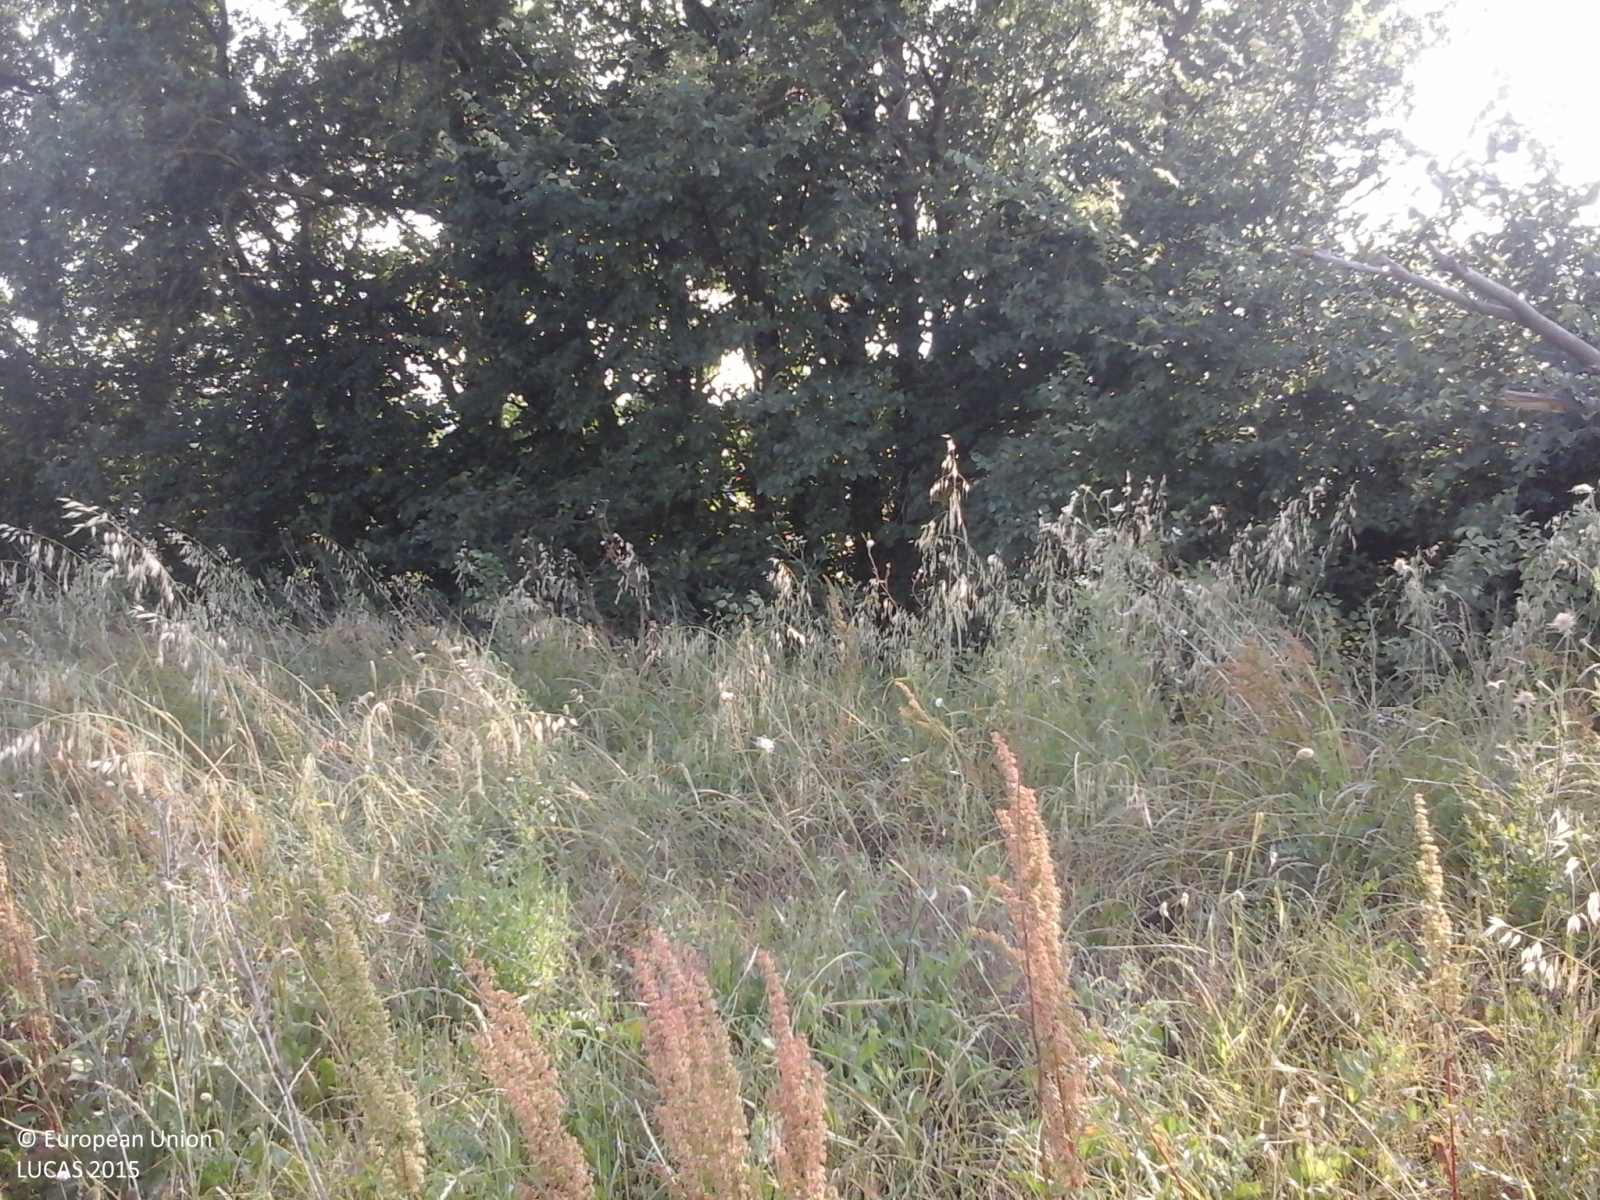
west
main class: Grassland
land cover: Spontaneously vegetated surfaces
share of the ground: > 75 %
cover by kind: herbaceous plants 100 %
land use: Fallow land
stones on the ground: < 10 %
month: June
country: IT
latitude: 41.0766
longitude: 15.1108
